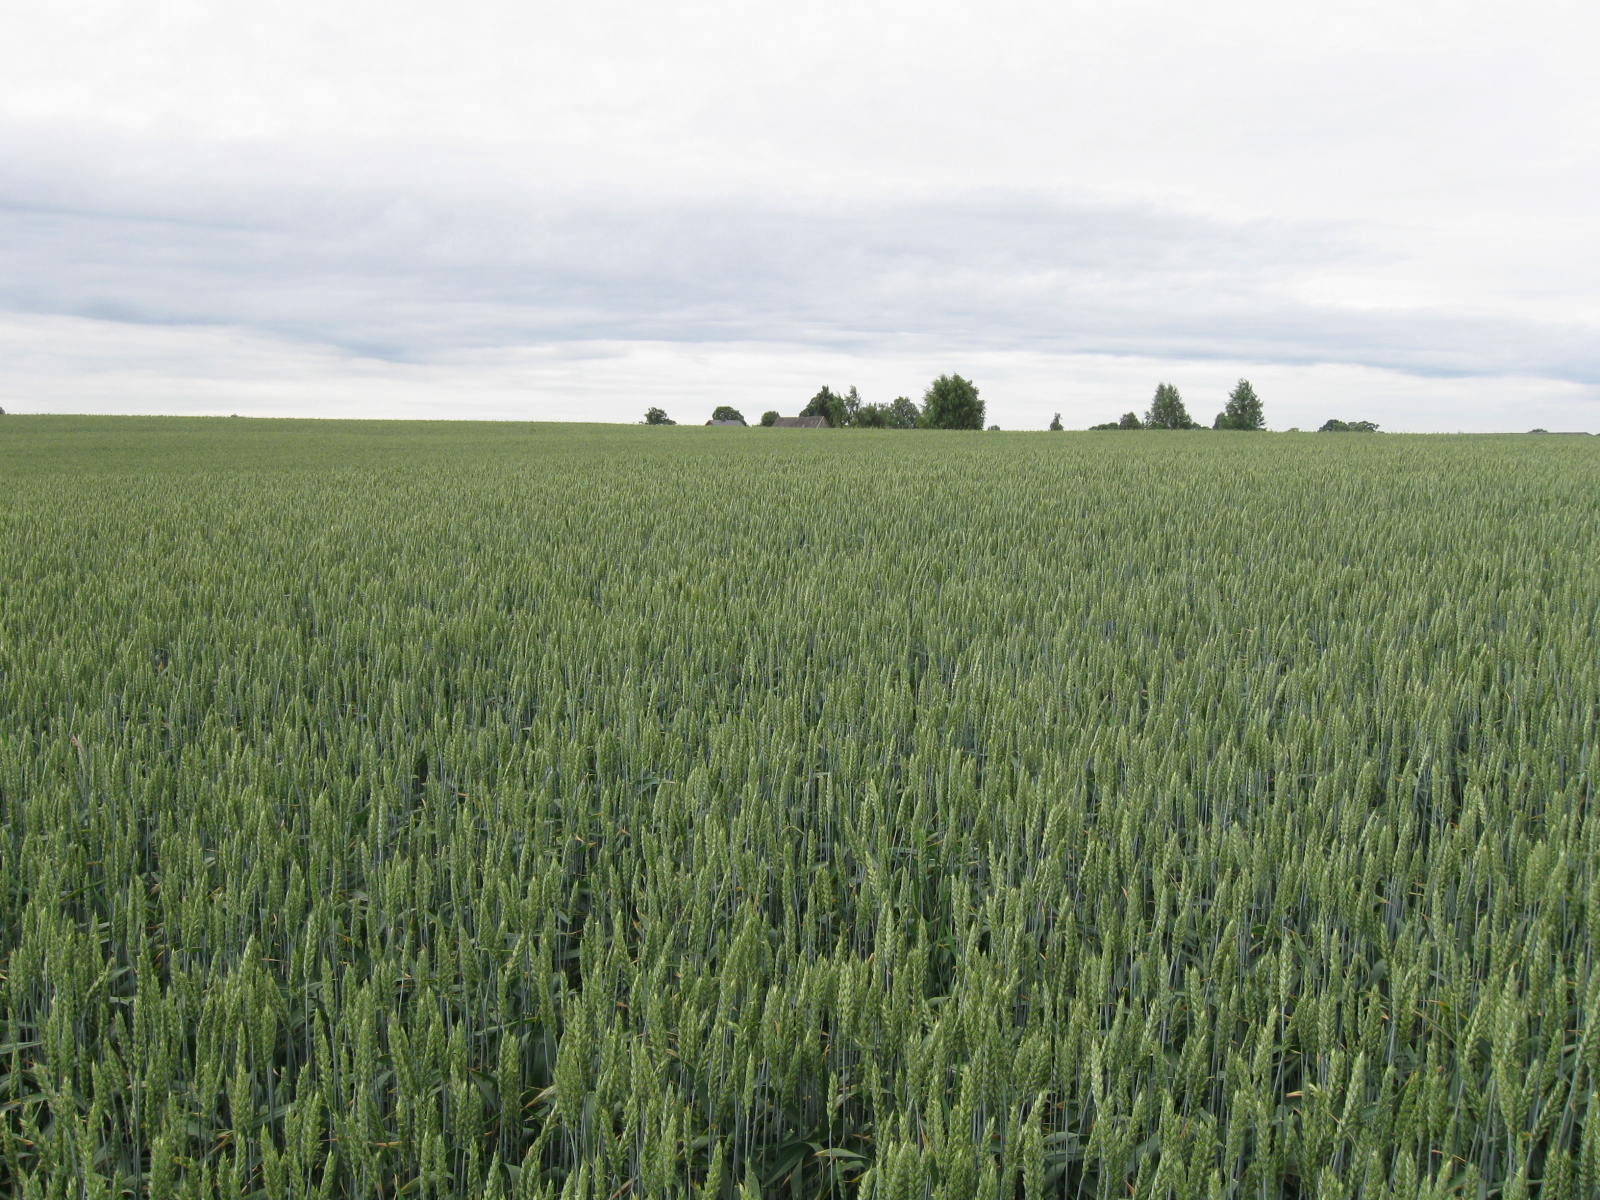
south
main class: Cropland
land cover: Common wheat
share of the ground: > 75 %
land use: Agriculture (excluding fallow land and kitchen gardens)
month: July
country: LT
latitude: 55.0338
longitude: 23.6487
